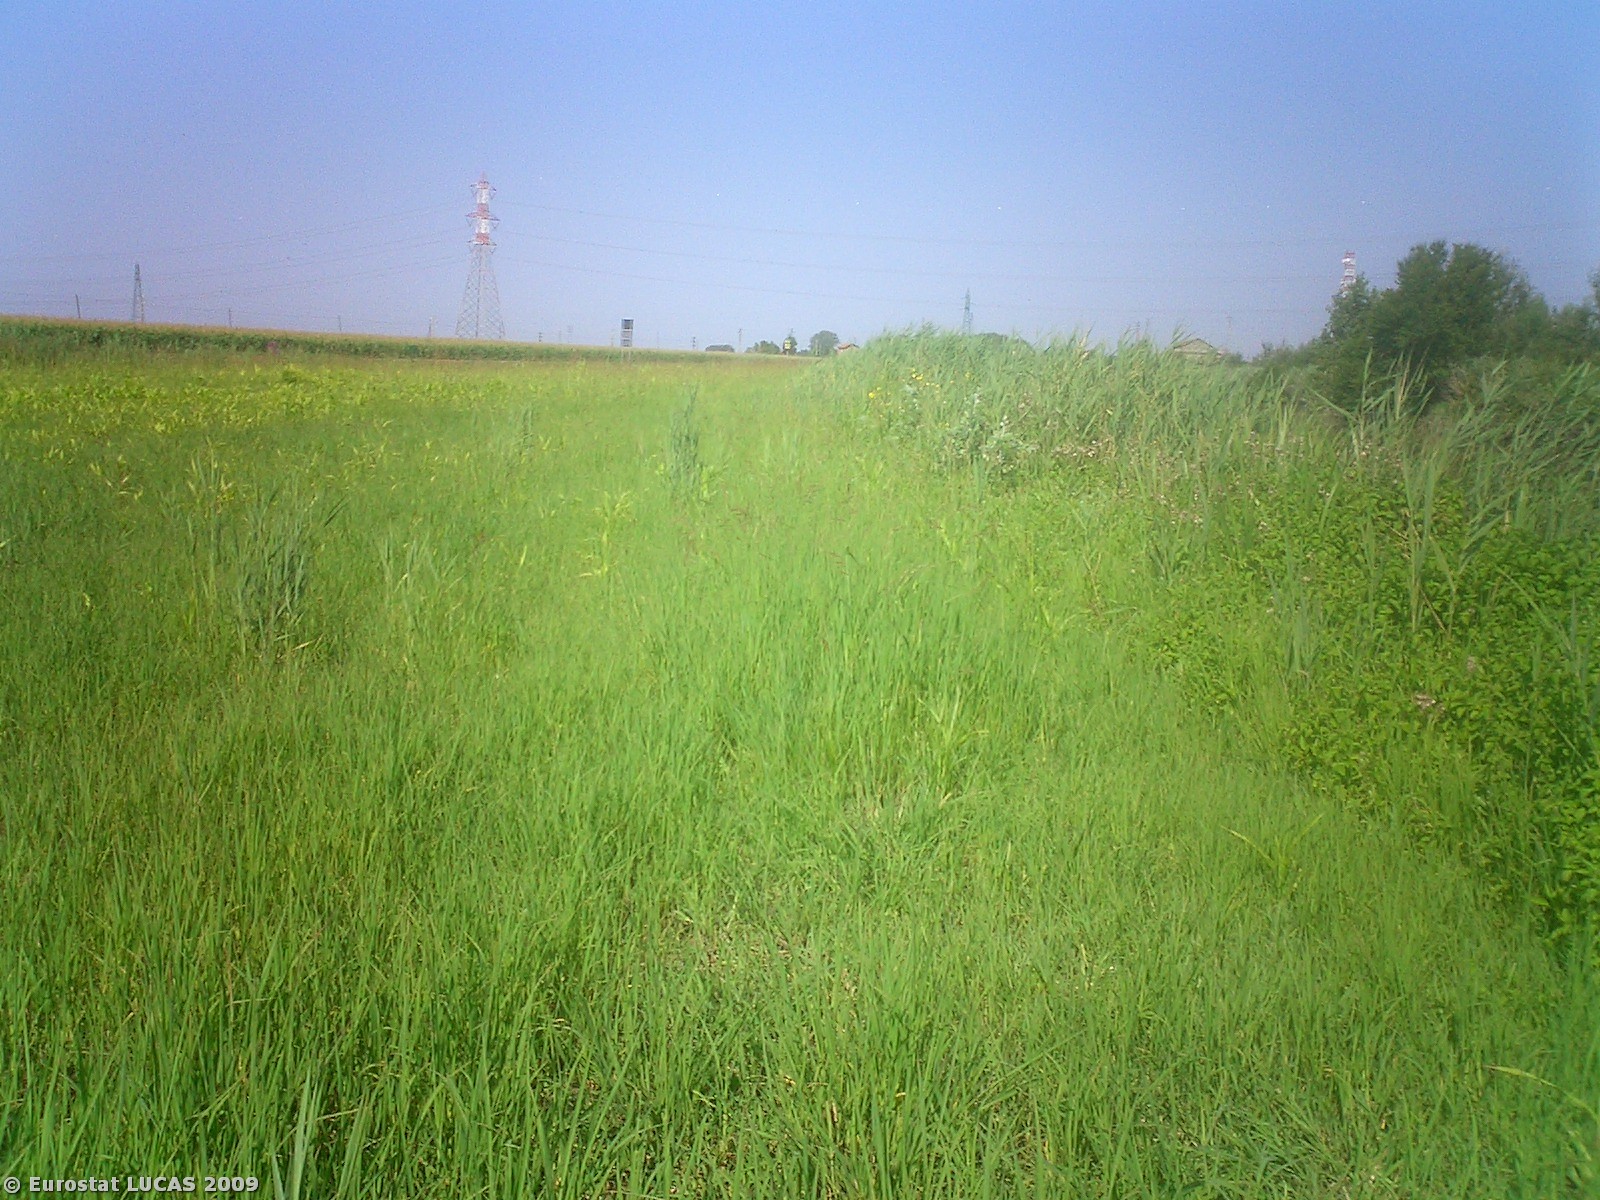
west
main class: Grassland
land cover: Grassland without tree/shrub cover
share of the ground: > 75 %
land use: Agriculture (excluding fallow land and kitchen gardens)
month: July
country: IT
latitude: 44.8347
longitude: 12.0832
